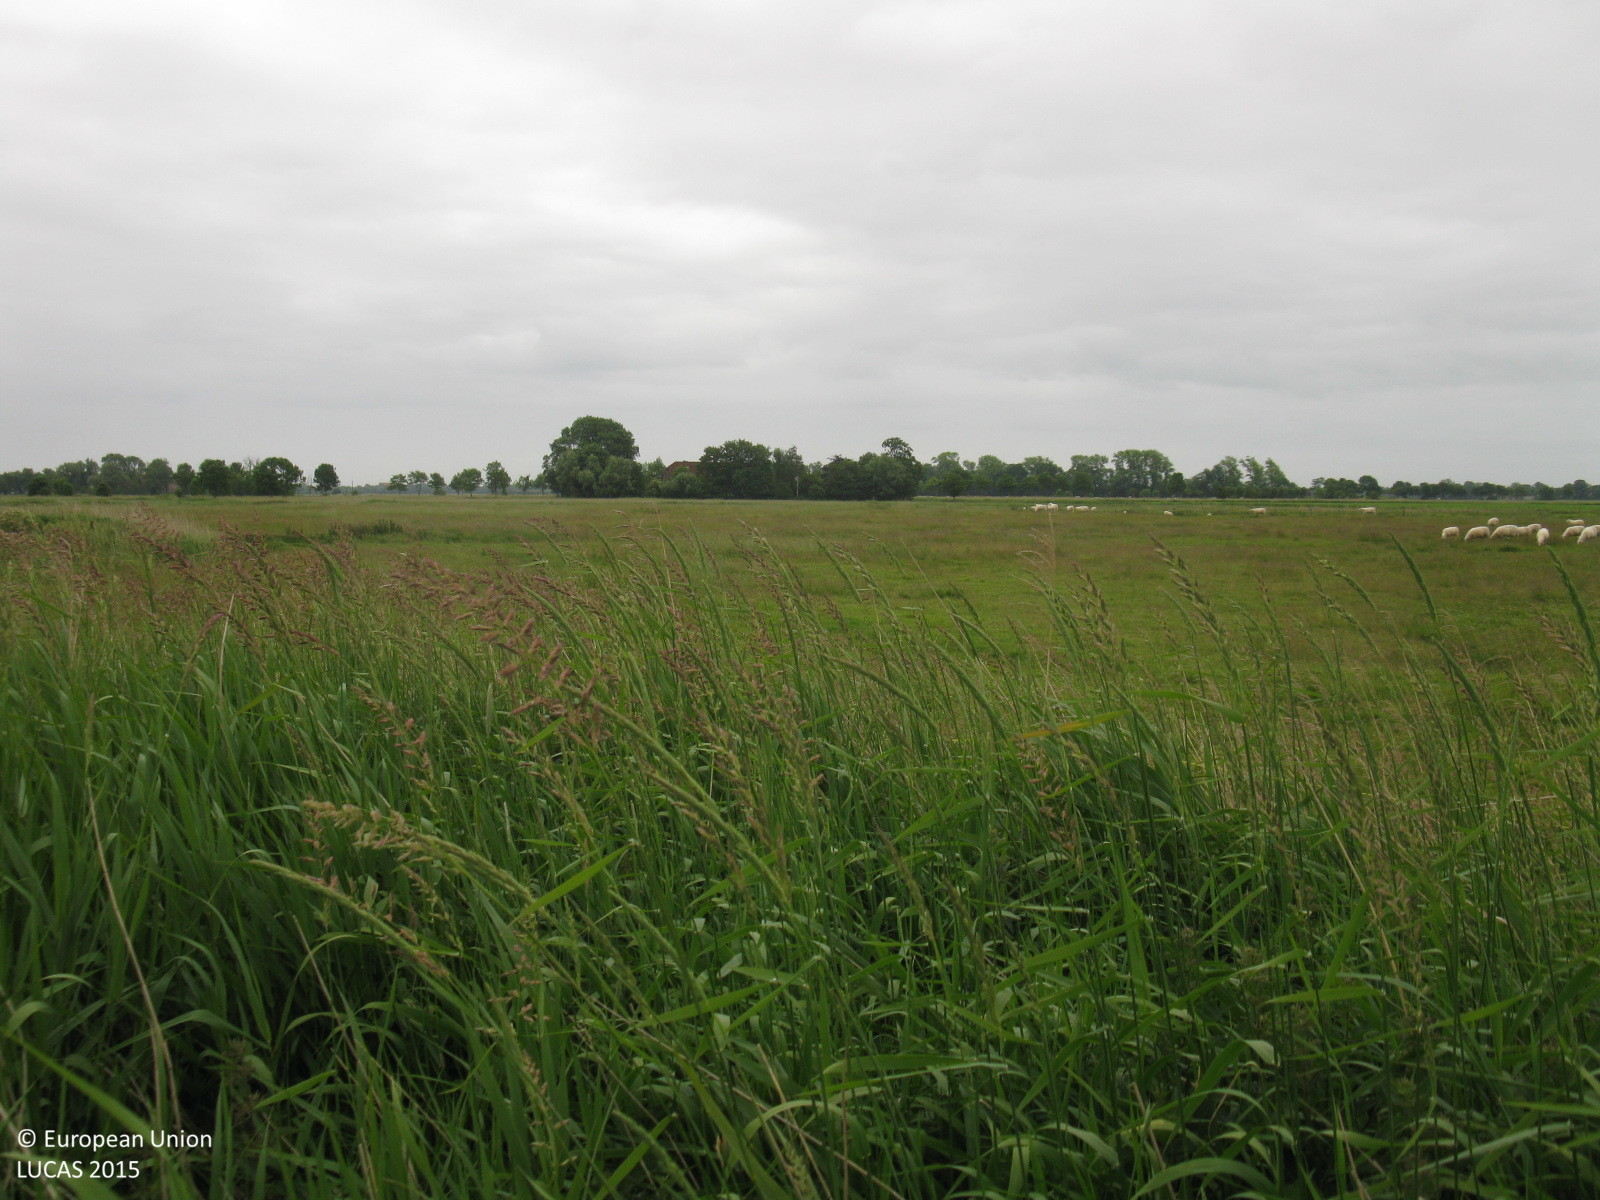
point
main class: Grassland
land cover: Grassland without tree/shrub cover
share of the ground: > 75 %
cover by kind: herbaceous plants 100 %
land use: Agriculture (excluding fallow land and kitchen gardens)
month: June
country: DE
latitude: 53.6005
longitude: 7.9607
